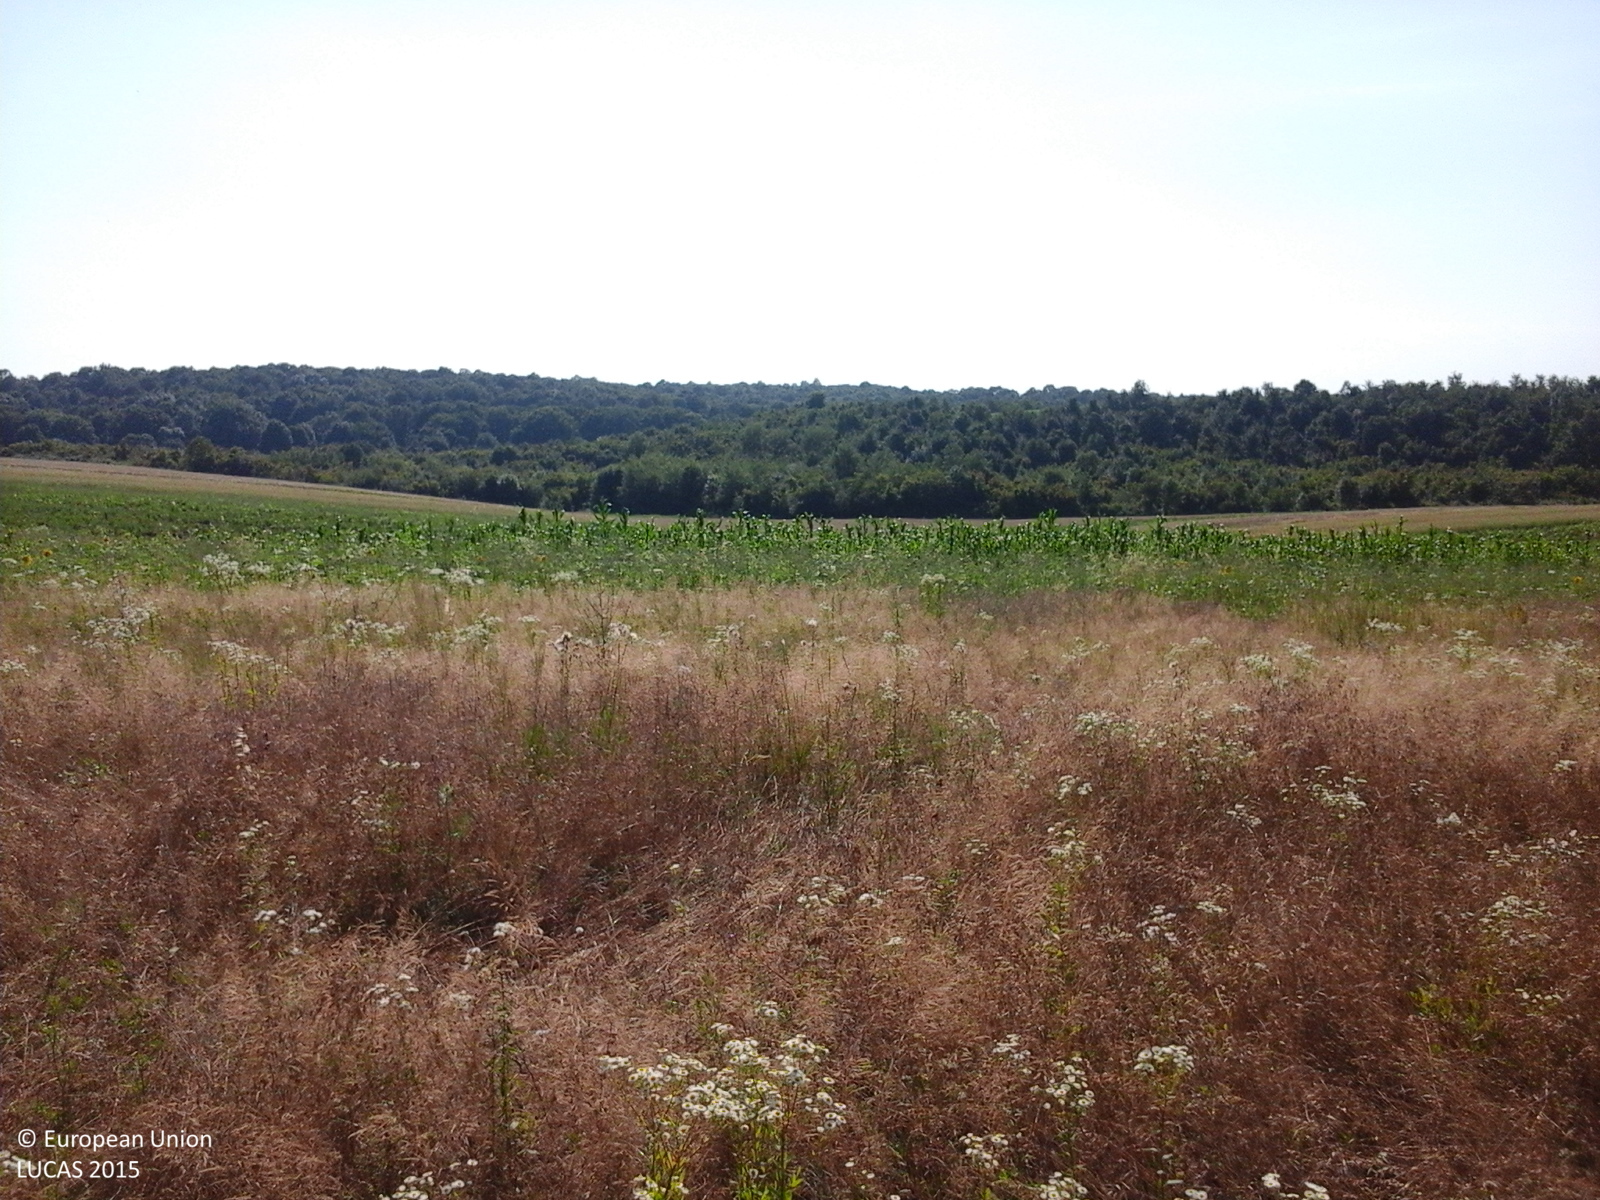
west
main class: Grassland
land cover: Spontaneously vegetated surfaces
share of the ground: > 75 %
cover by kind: herbaceous plants 100 %
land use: Fallow land
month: July
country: RO
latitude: 44.5294
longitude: 24.6585
